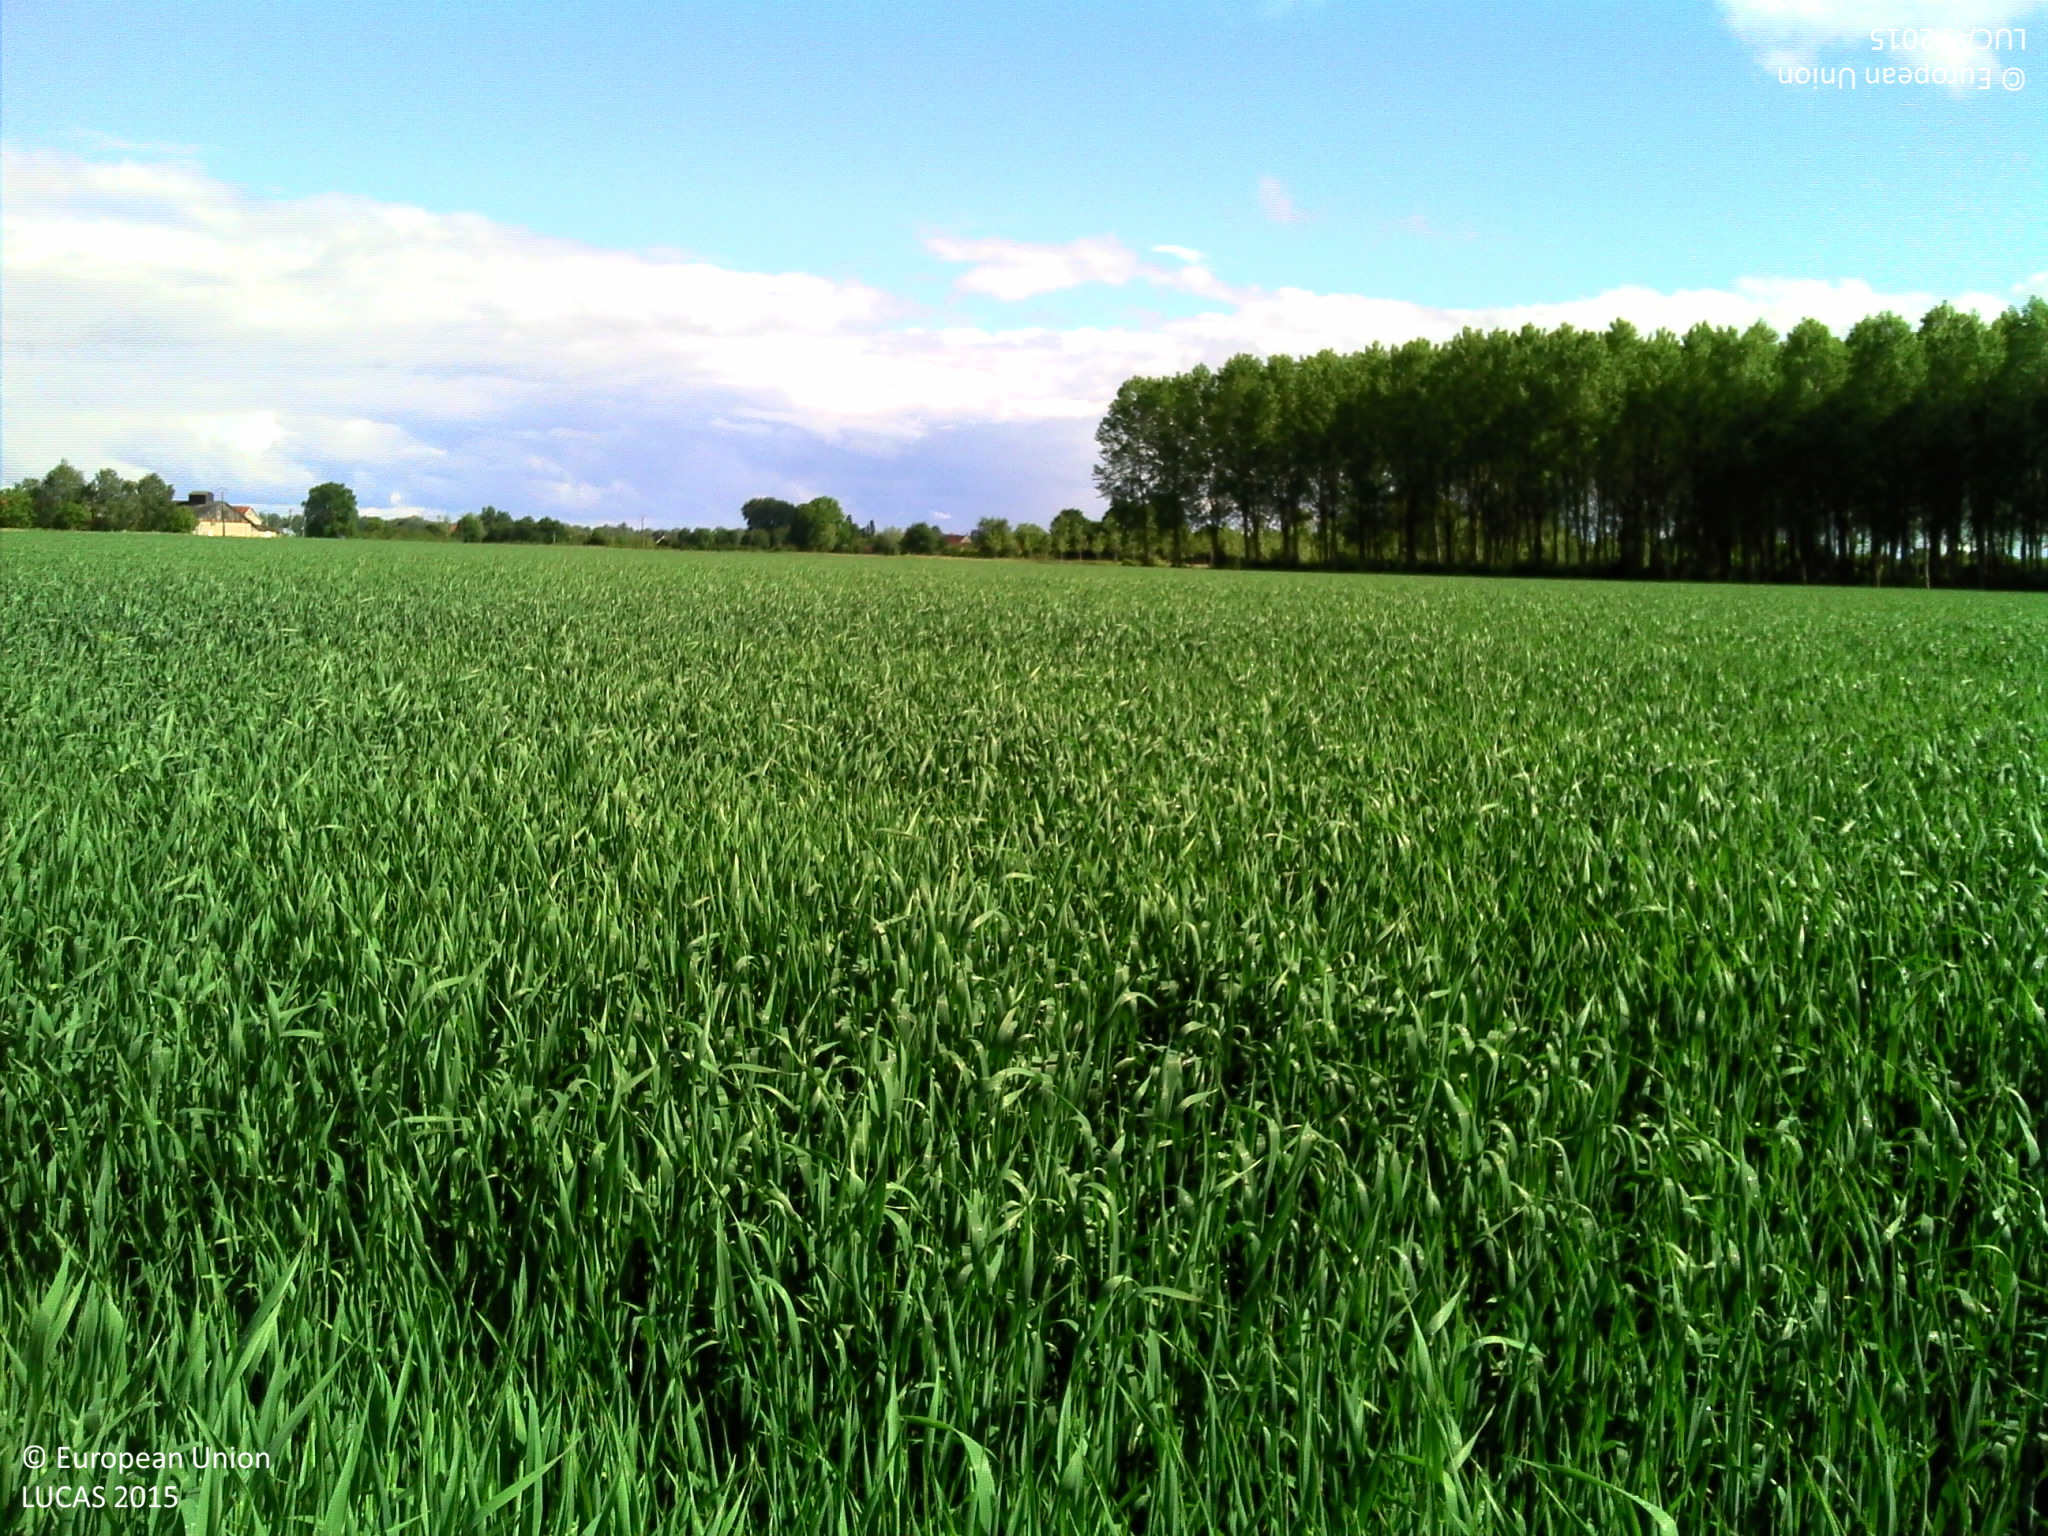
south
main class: Cropland
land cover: Oats
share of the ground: > 75 %
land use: Agriculture (excluding fallow land and kitchen gardens)
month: May
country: FR
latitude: 47.4524
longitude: 2.8981
